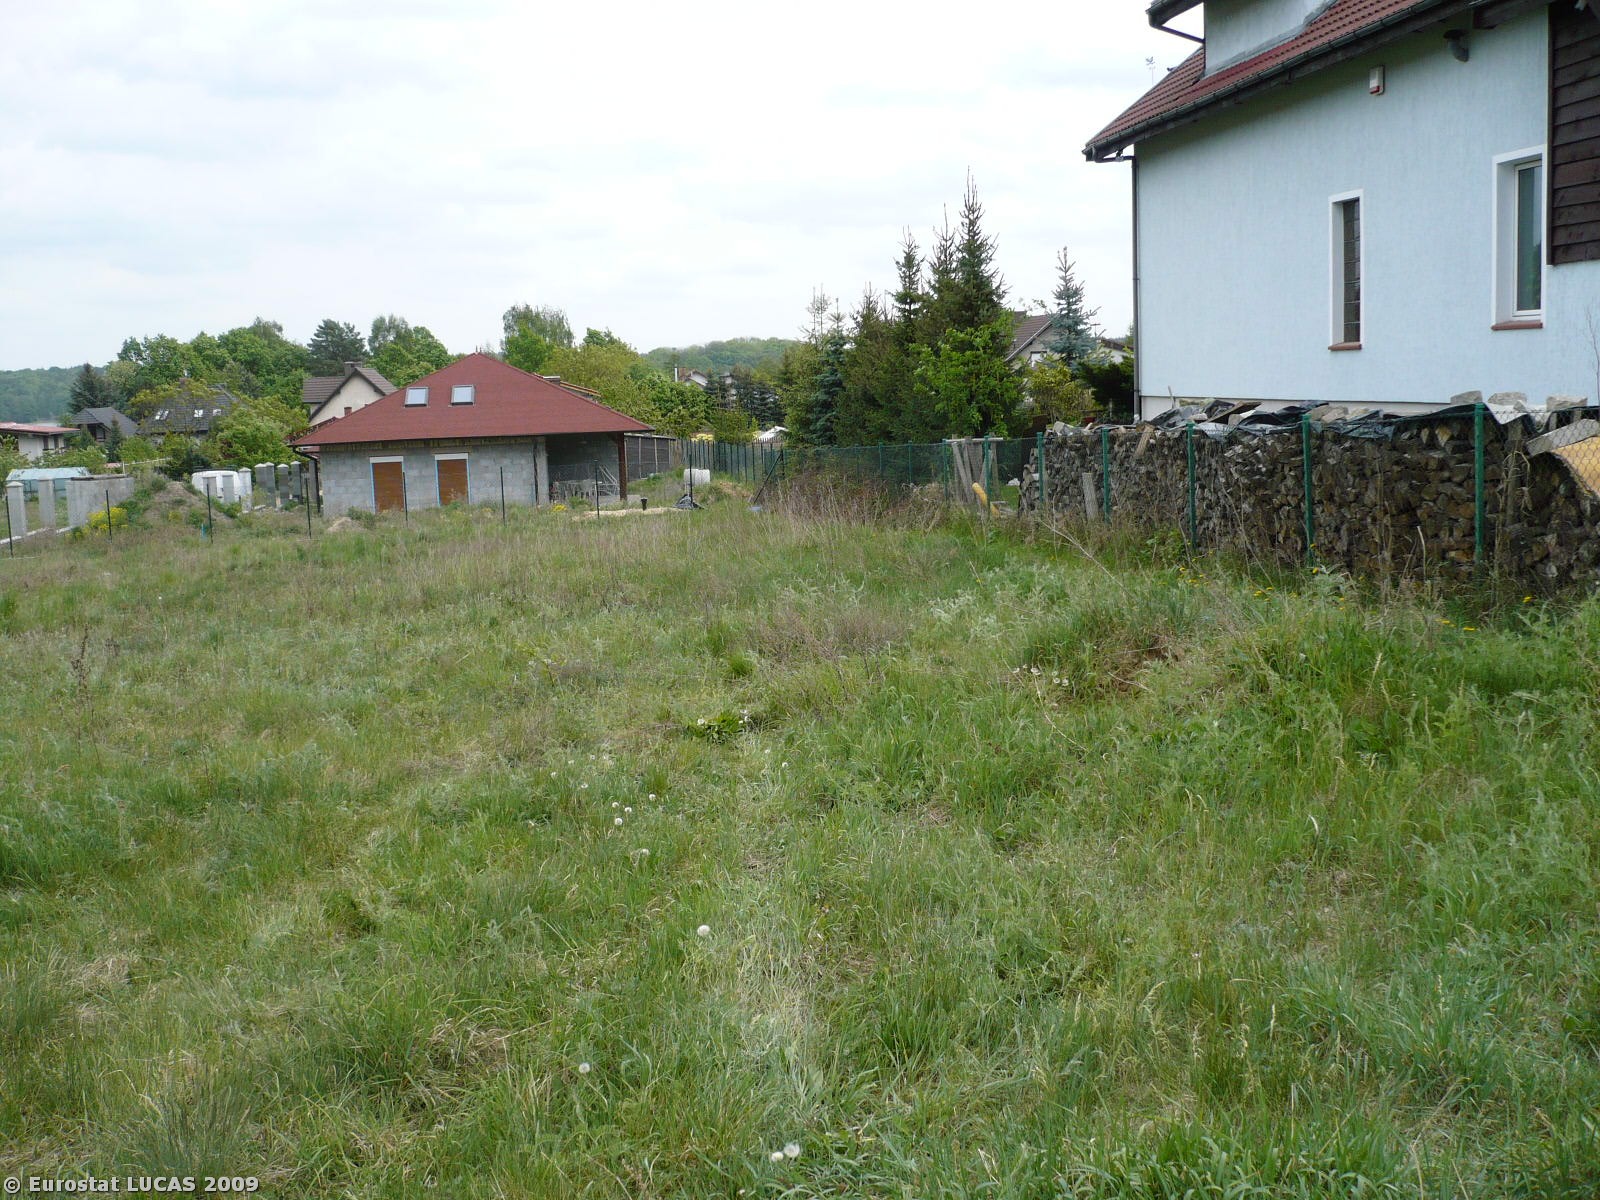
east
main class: Grassland
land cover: Spontaneously vegetated surfaces
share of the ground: > 75 %
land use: Unused
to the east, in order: Spontaneously vegetated surfaces; Fences; Artificial constructions in urban areas; Fences; Grassland without tree/shrub cover
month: May
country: PL
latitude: 52.2376
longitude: 15.3779
